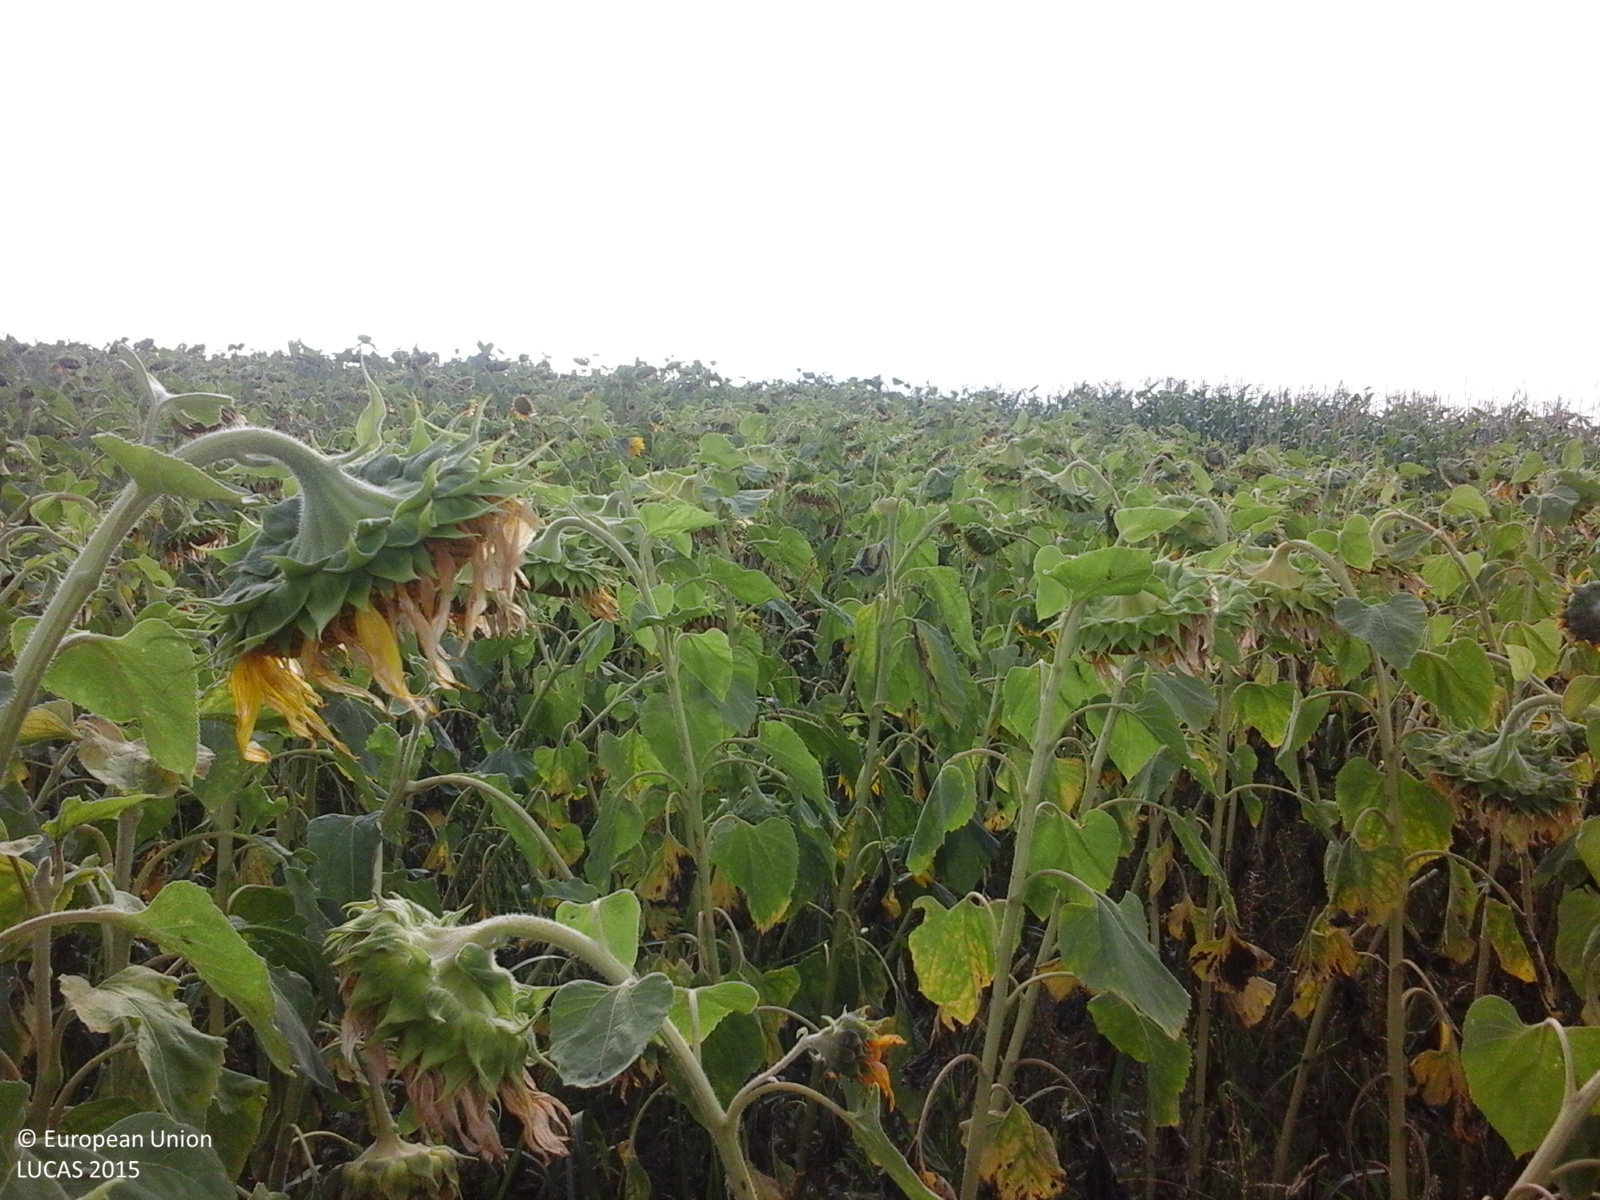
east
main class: Cropland
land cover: Sunflower
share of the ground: > 75 %
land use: Agriculture (excluding fallow land and kitchen gardens)
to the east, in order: Sunflower; Maize
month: August
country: RO
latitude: 45.1143
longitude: 28.8660
